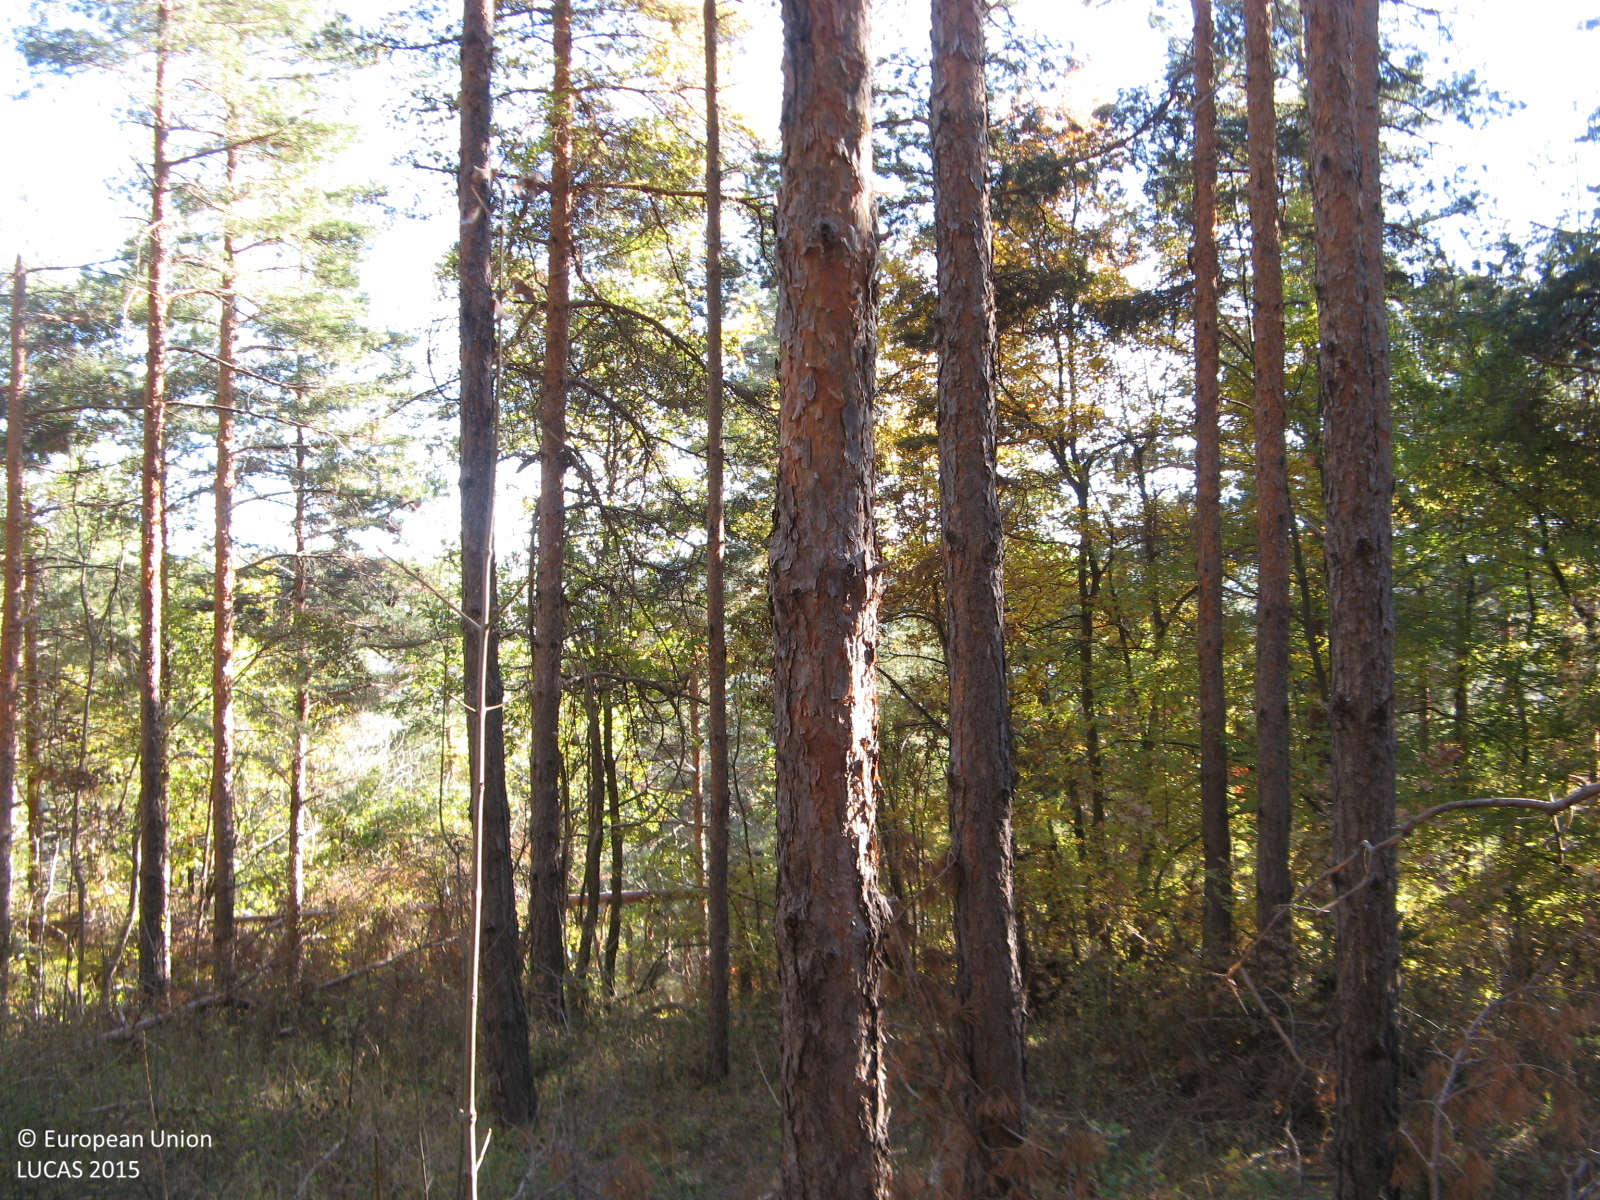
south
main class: Woodland
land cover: Pine dominated mixed woodland
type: hemiboreal forest and nemoral coniferous forest and mixed broadleaved-coniferous forest
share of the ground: > 75 %
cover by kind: coniferous forest trees 75 %, broadleaved forest trees 25 %
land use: Forestry
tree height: > 5 m
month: November
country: BG
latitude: 41.6572
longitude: 25.2455
